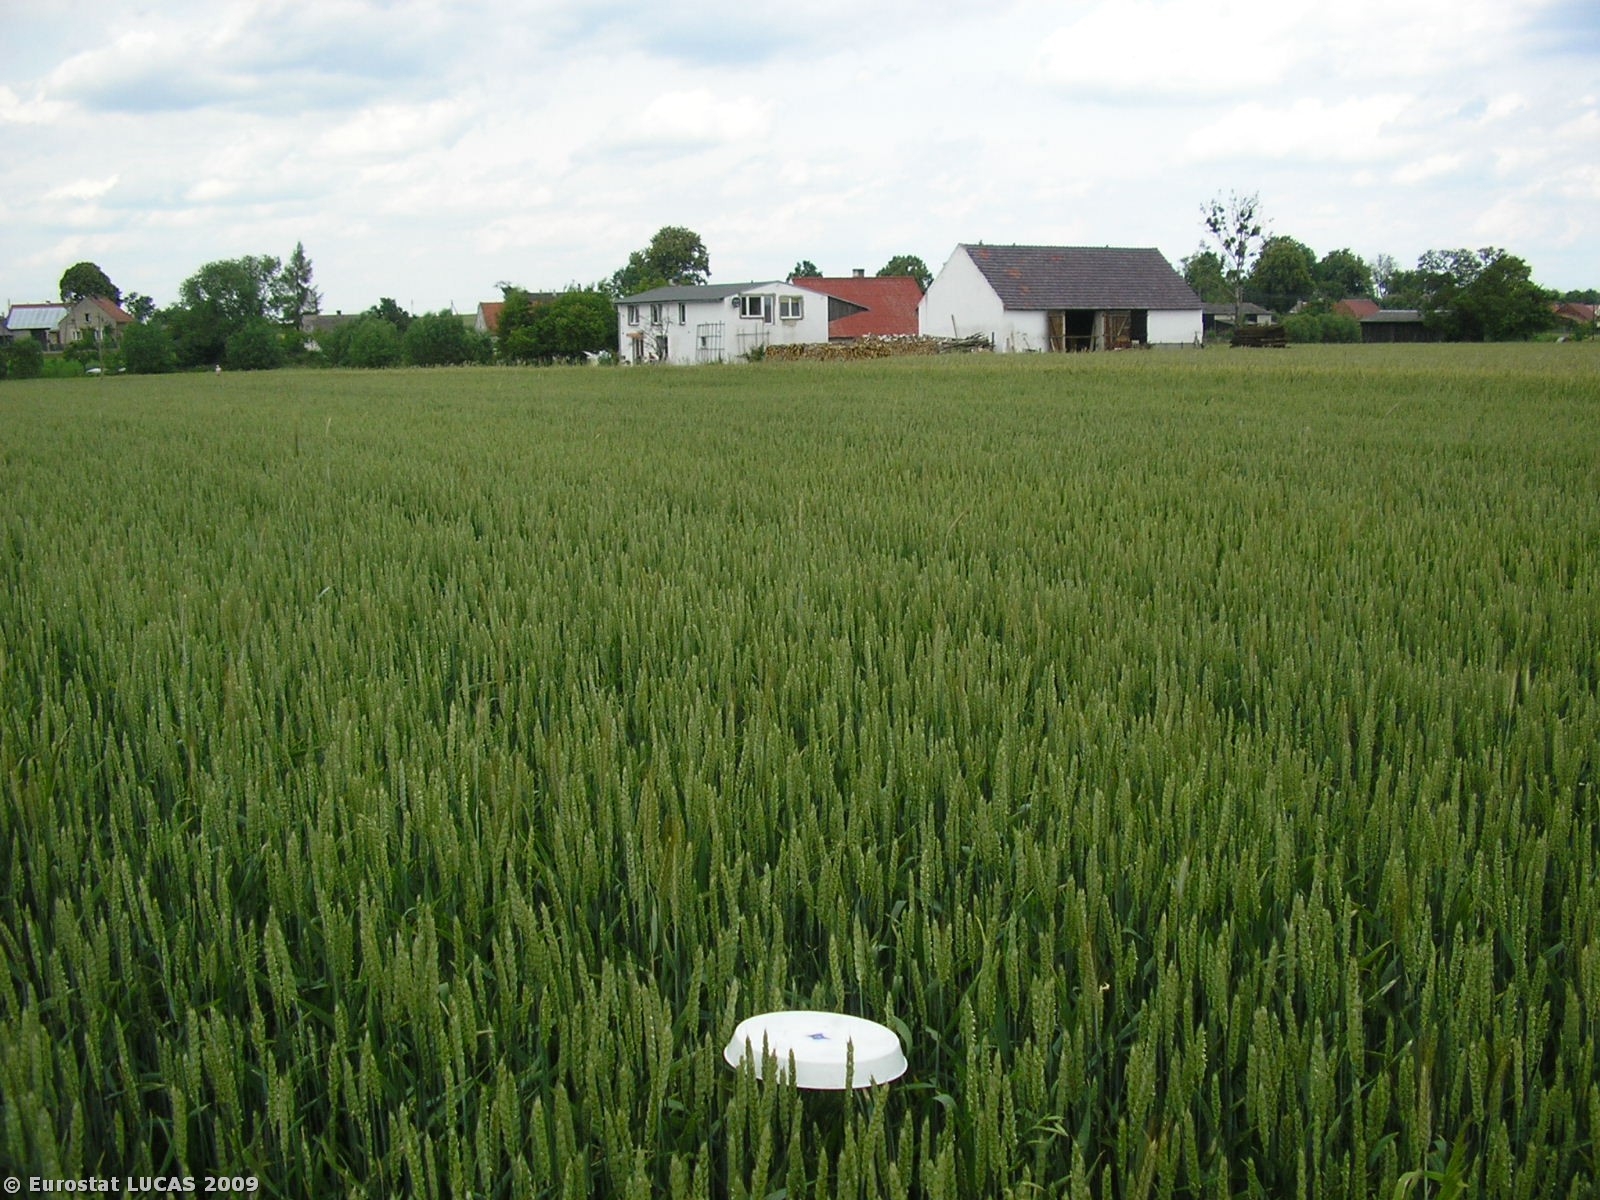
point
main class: Cropland
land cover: Common wheat
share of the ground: > 75 %
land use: Agriculture (excluding fallow land and kitchen gardens)
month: June
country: PL
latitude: 51.0736
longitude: 18.3103
